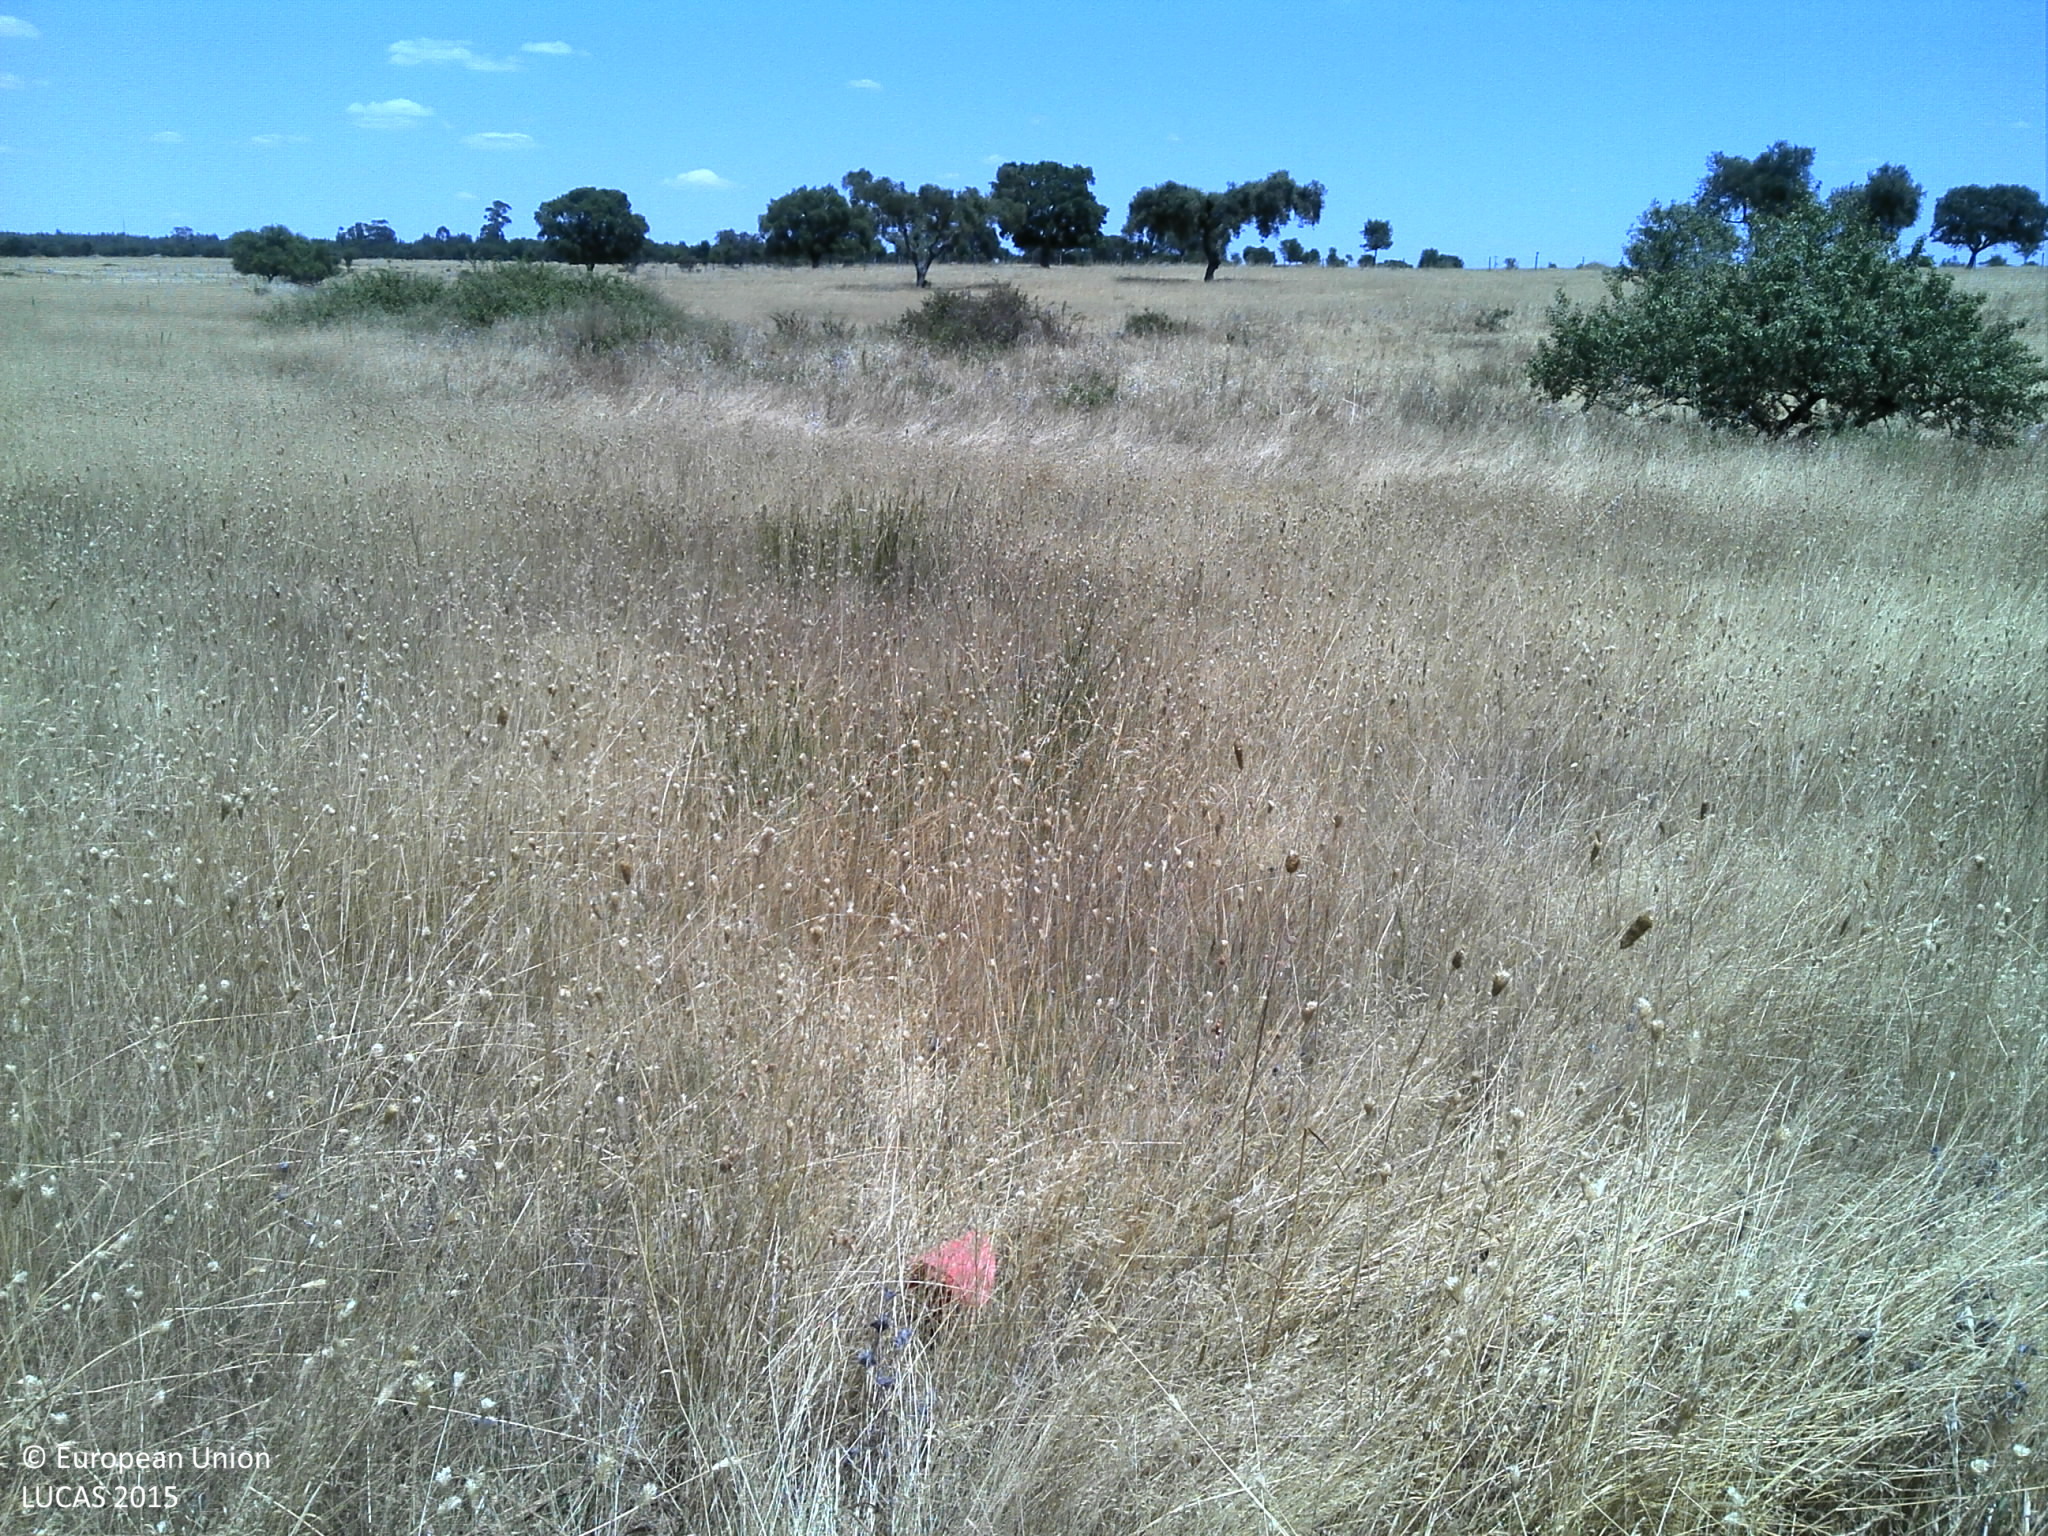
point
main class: Grassland
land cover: Grassland without tree/shrub cover
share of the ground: > 75 %
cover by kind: herbaceous plants 80 %, unconsolidated bare surface 20 %
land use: Agriculture (excluding fallow land and kitchen gardens)
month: June
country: PT
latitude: 38.3755
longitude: -8.1386
